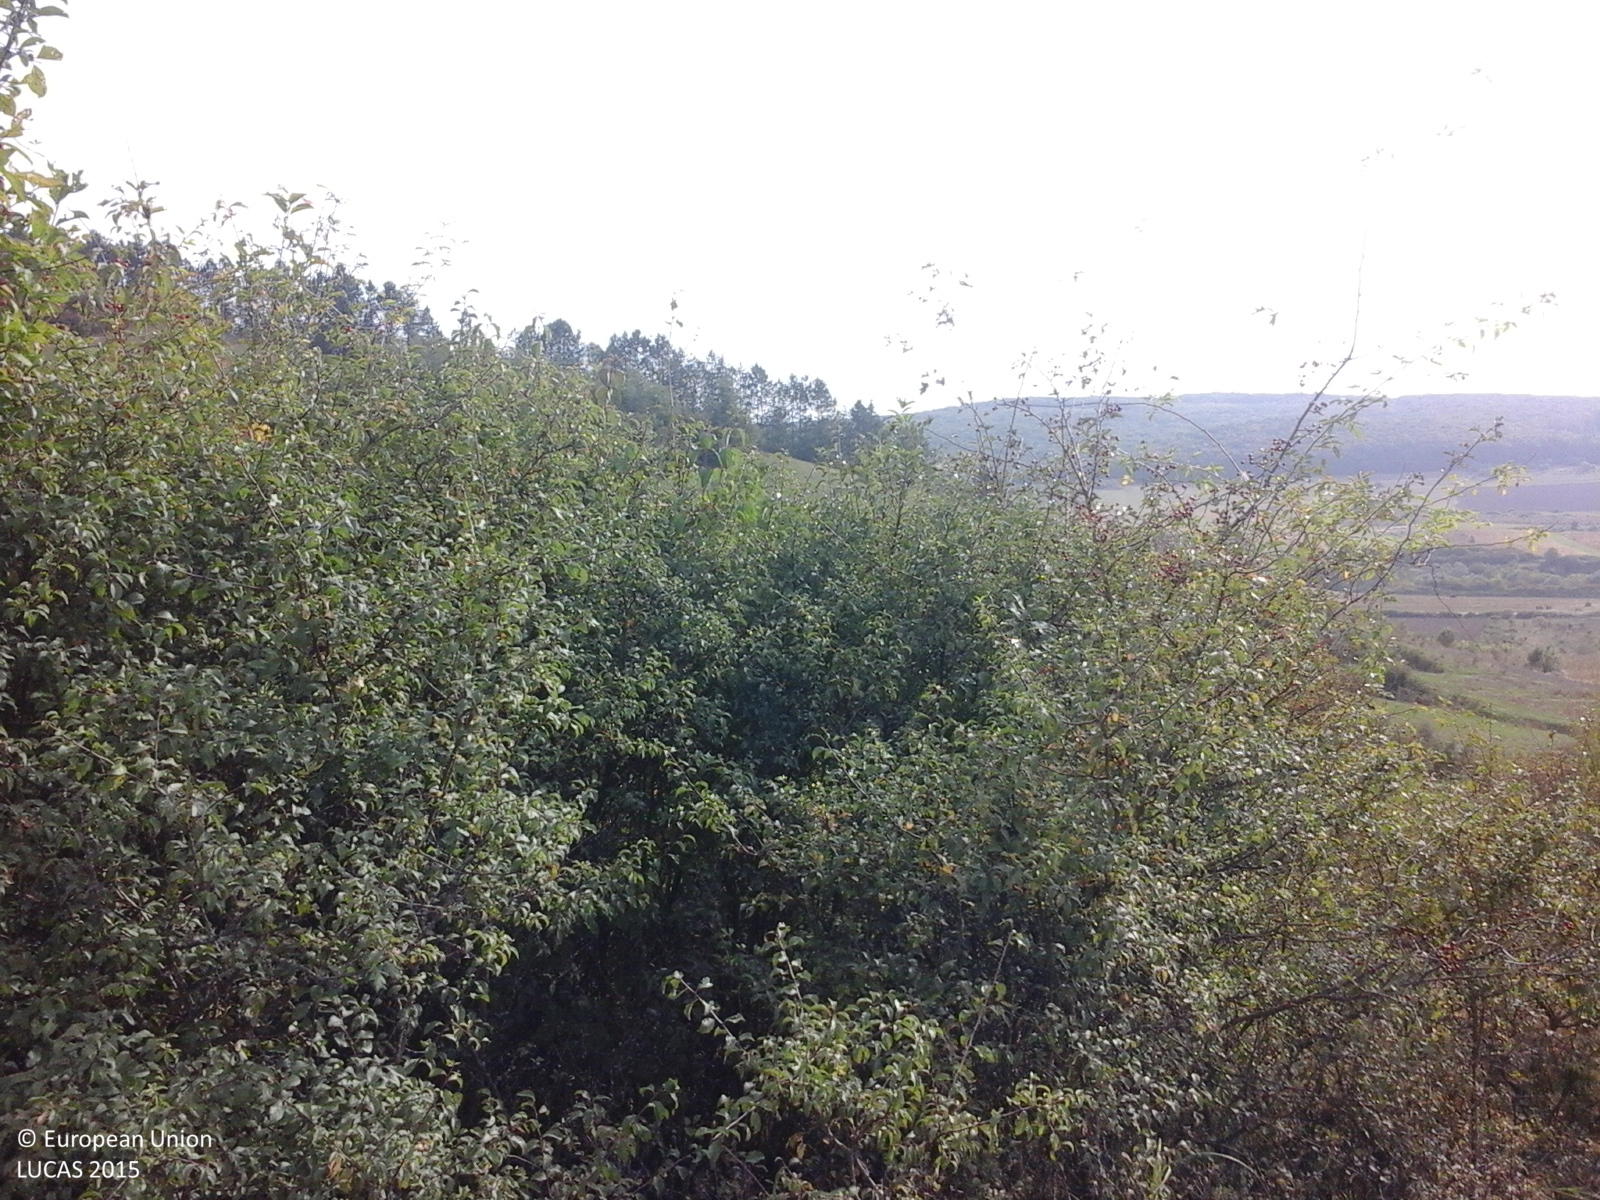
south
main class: Grassland
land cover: Spontaneously vegetated surfaces
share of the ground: > 75 %
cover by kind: herbaceous plants 100 %
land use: Fallow land
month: September
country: RO
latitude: 47.1287
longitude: 23.9617
